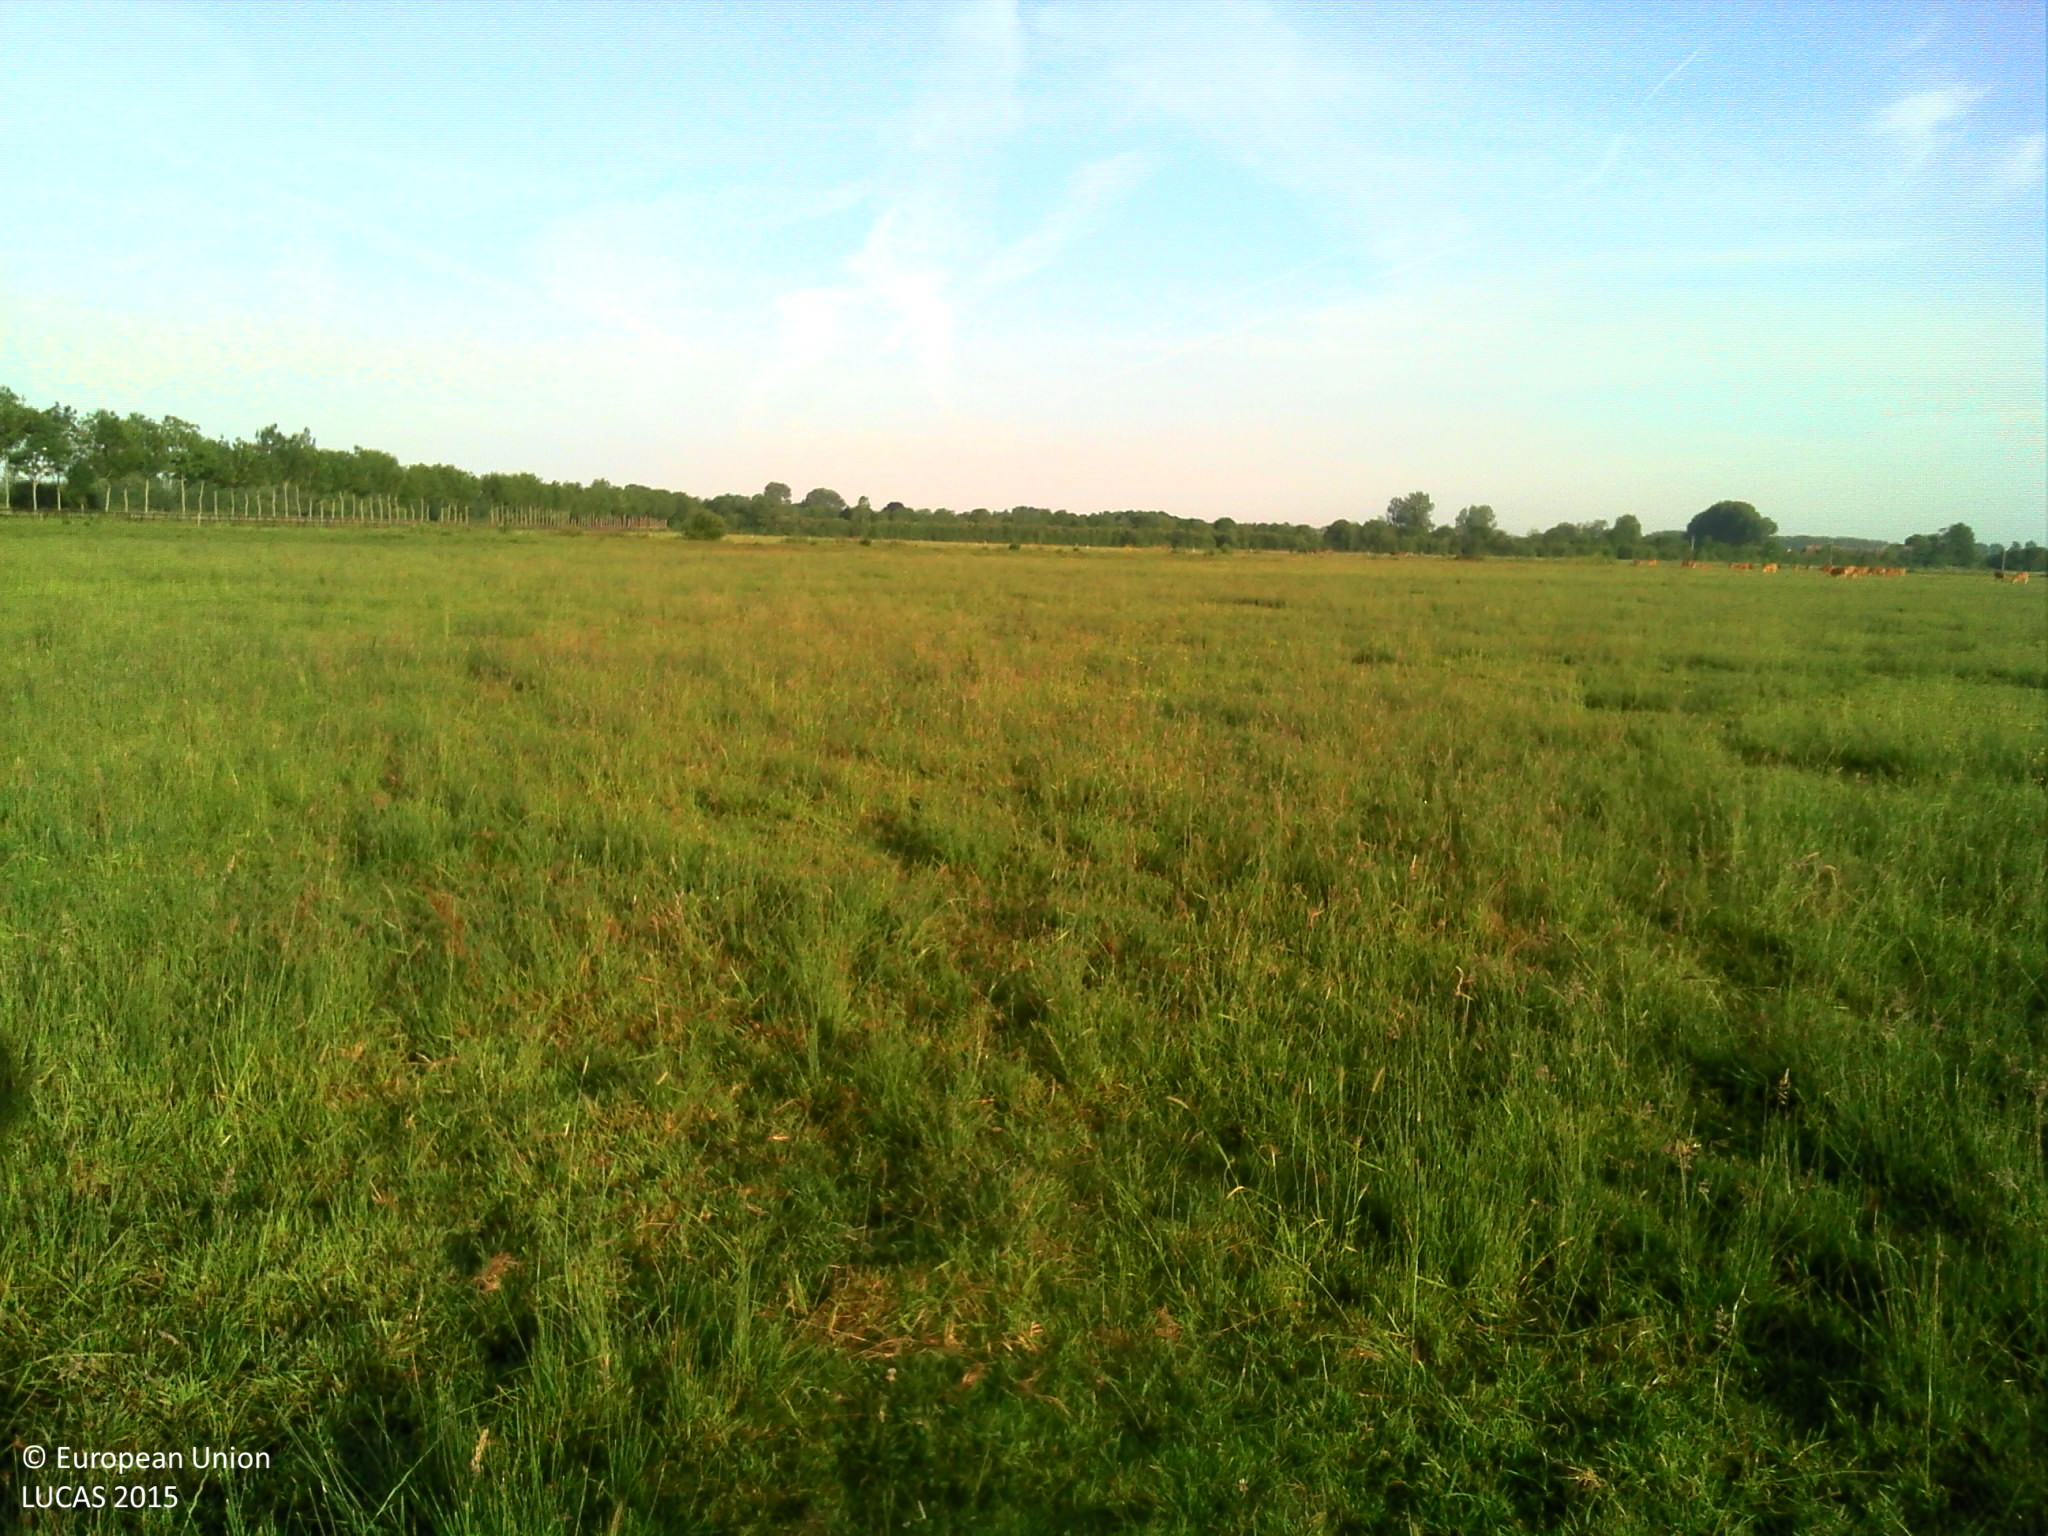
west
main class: Grassland
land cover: Grassland without tree/shrub cover
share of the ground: > 75 %
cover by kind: herbaceous plants 100 %
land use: Agriculture (excluding fallow land and kitchen gardens)
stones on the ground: < 10 %
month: June
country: FR
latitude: 49.1254
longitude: -0.0209
